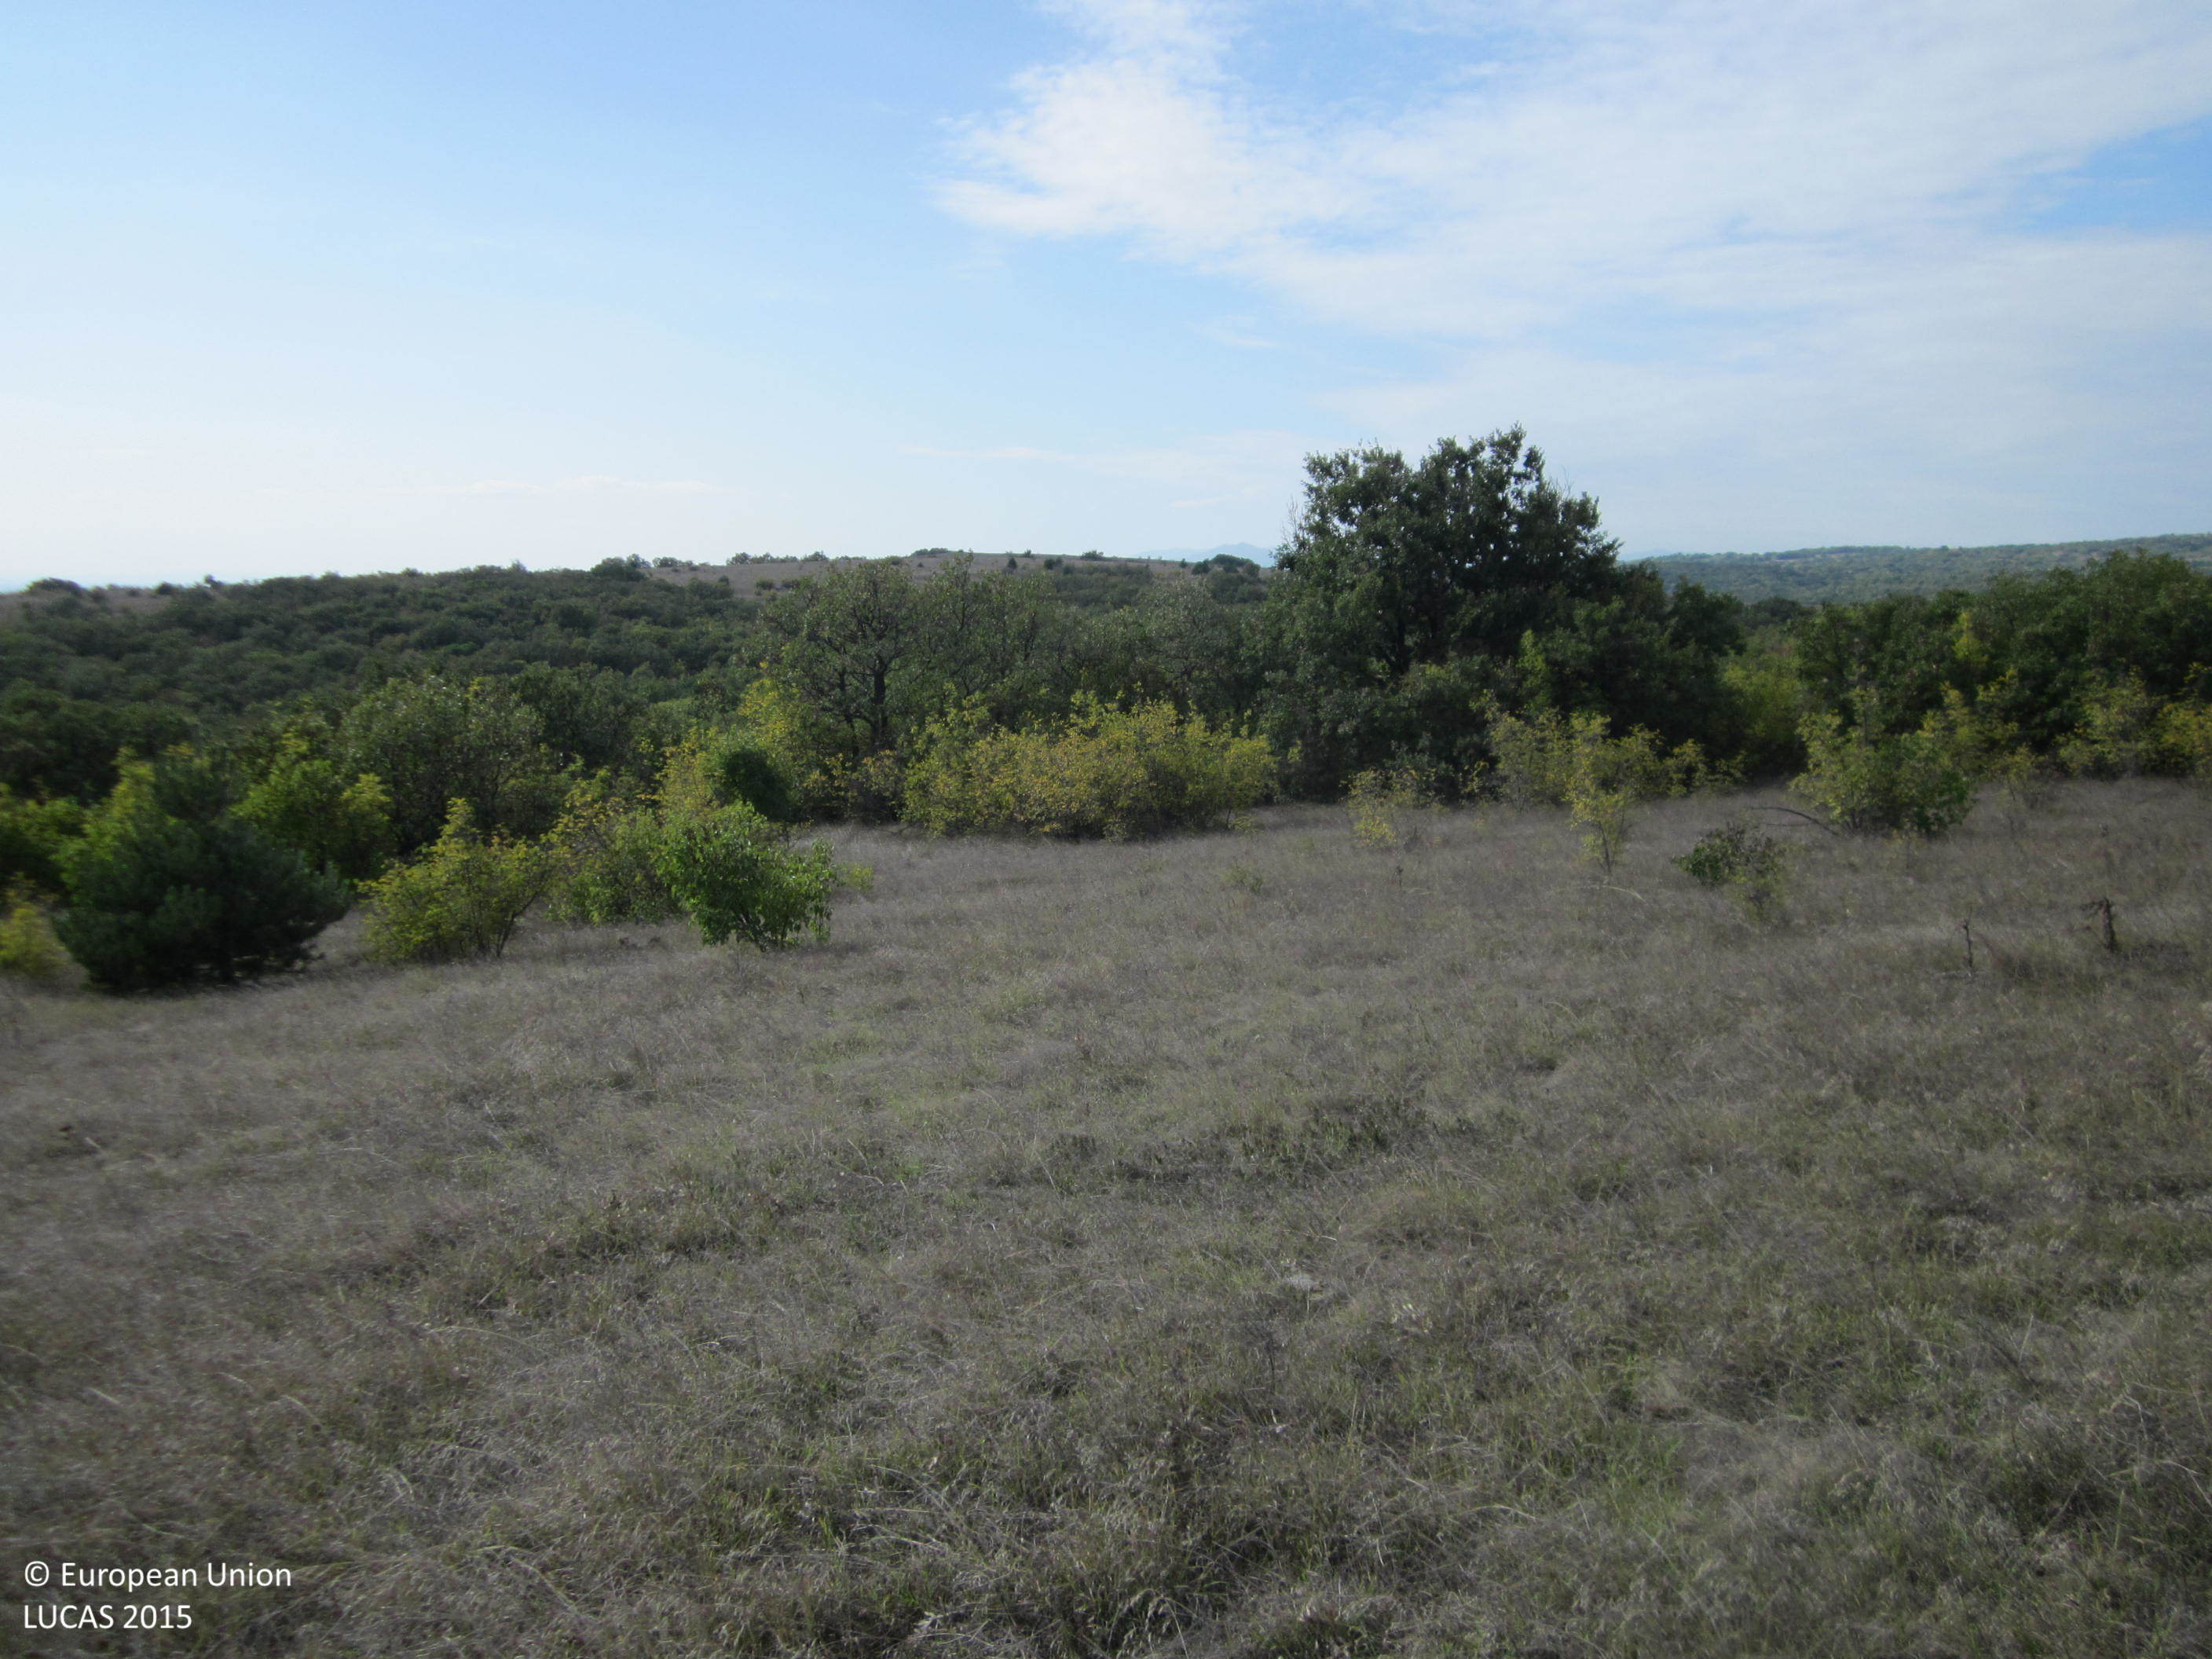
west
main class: Grassland
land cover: Grassland with sparse tree/shrub cover
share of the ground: > 75 %
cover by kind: herbaceous plants 90 %, coniferous forest trees 5 %, shrubs 5 %
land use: Semi-natural and natural areas not in use
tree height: < 5 m
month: October
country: BG
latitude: 42.6598
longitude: 26.7781
